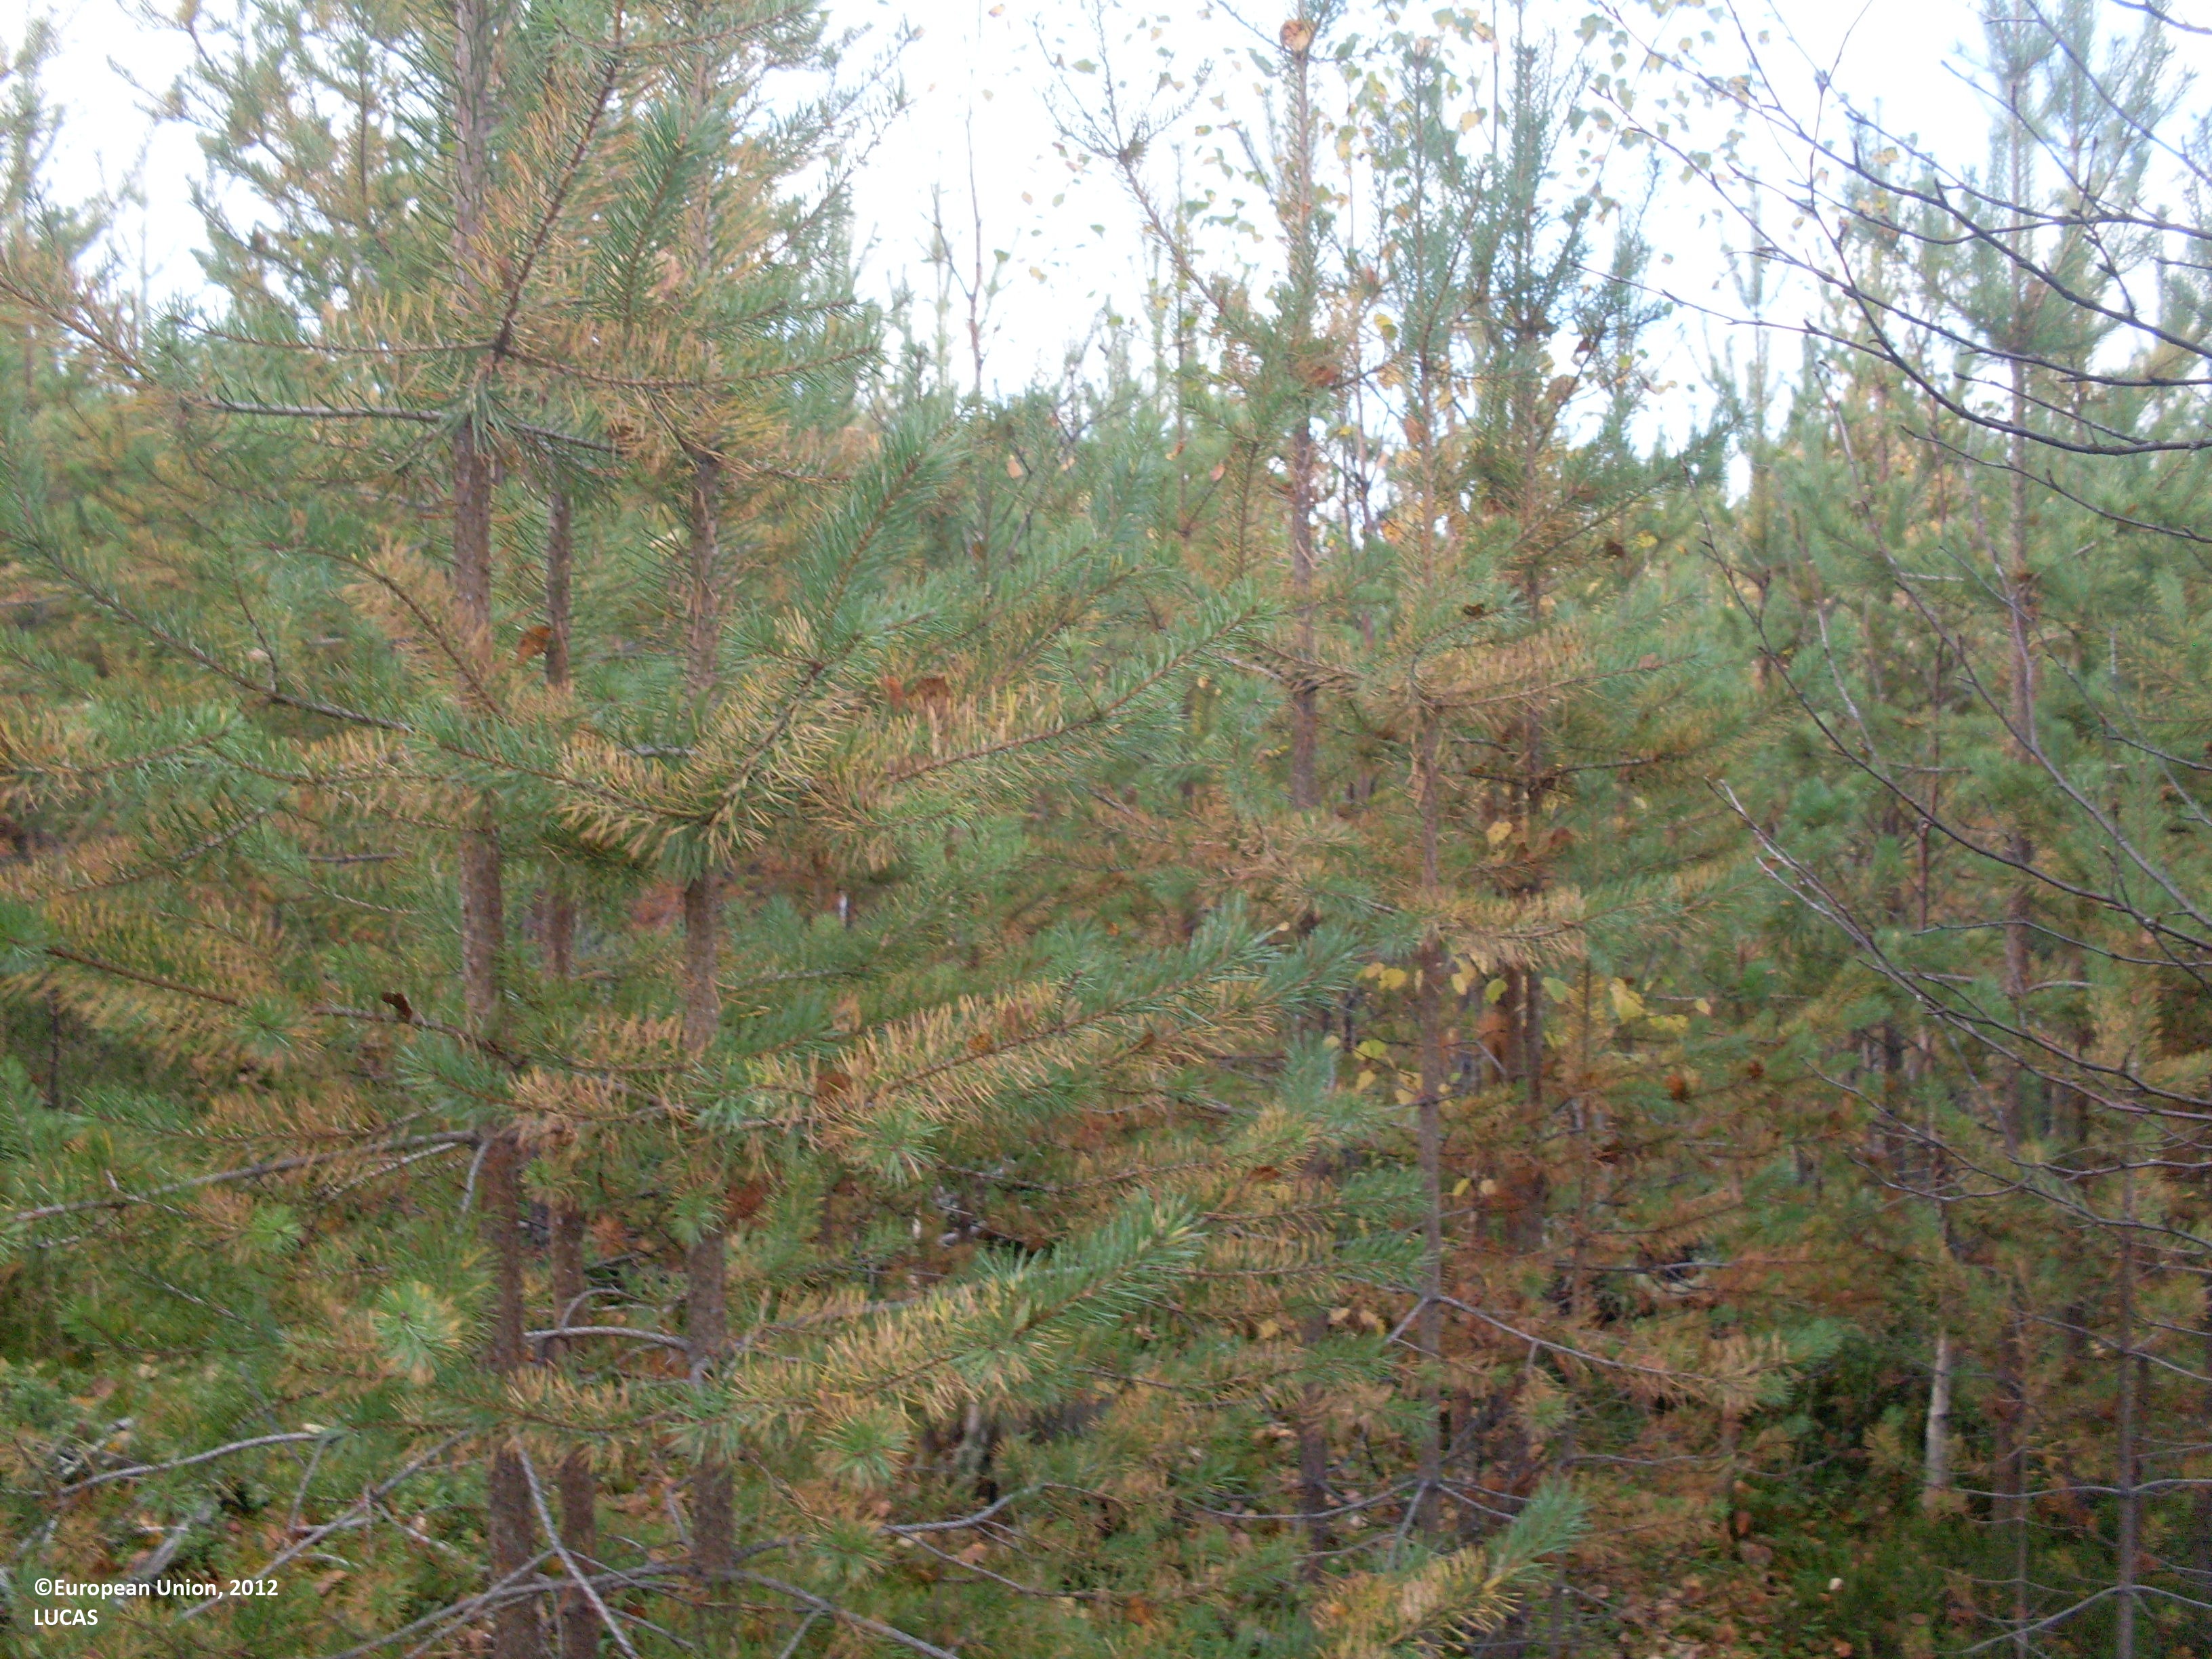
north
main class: Woodland
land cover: Pine dominated coniferous woodland
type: boreal forest
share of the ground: 50 - 75 %
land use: Forestry
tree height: < 5 m
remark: Nursery
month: September
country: FI
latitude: 64.4112
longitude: 28.3716
